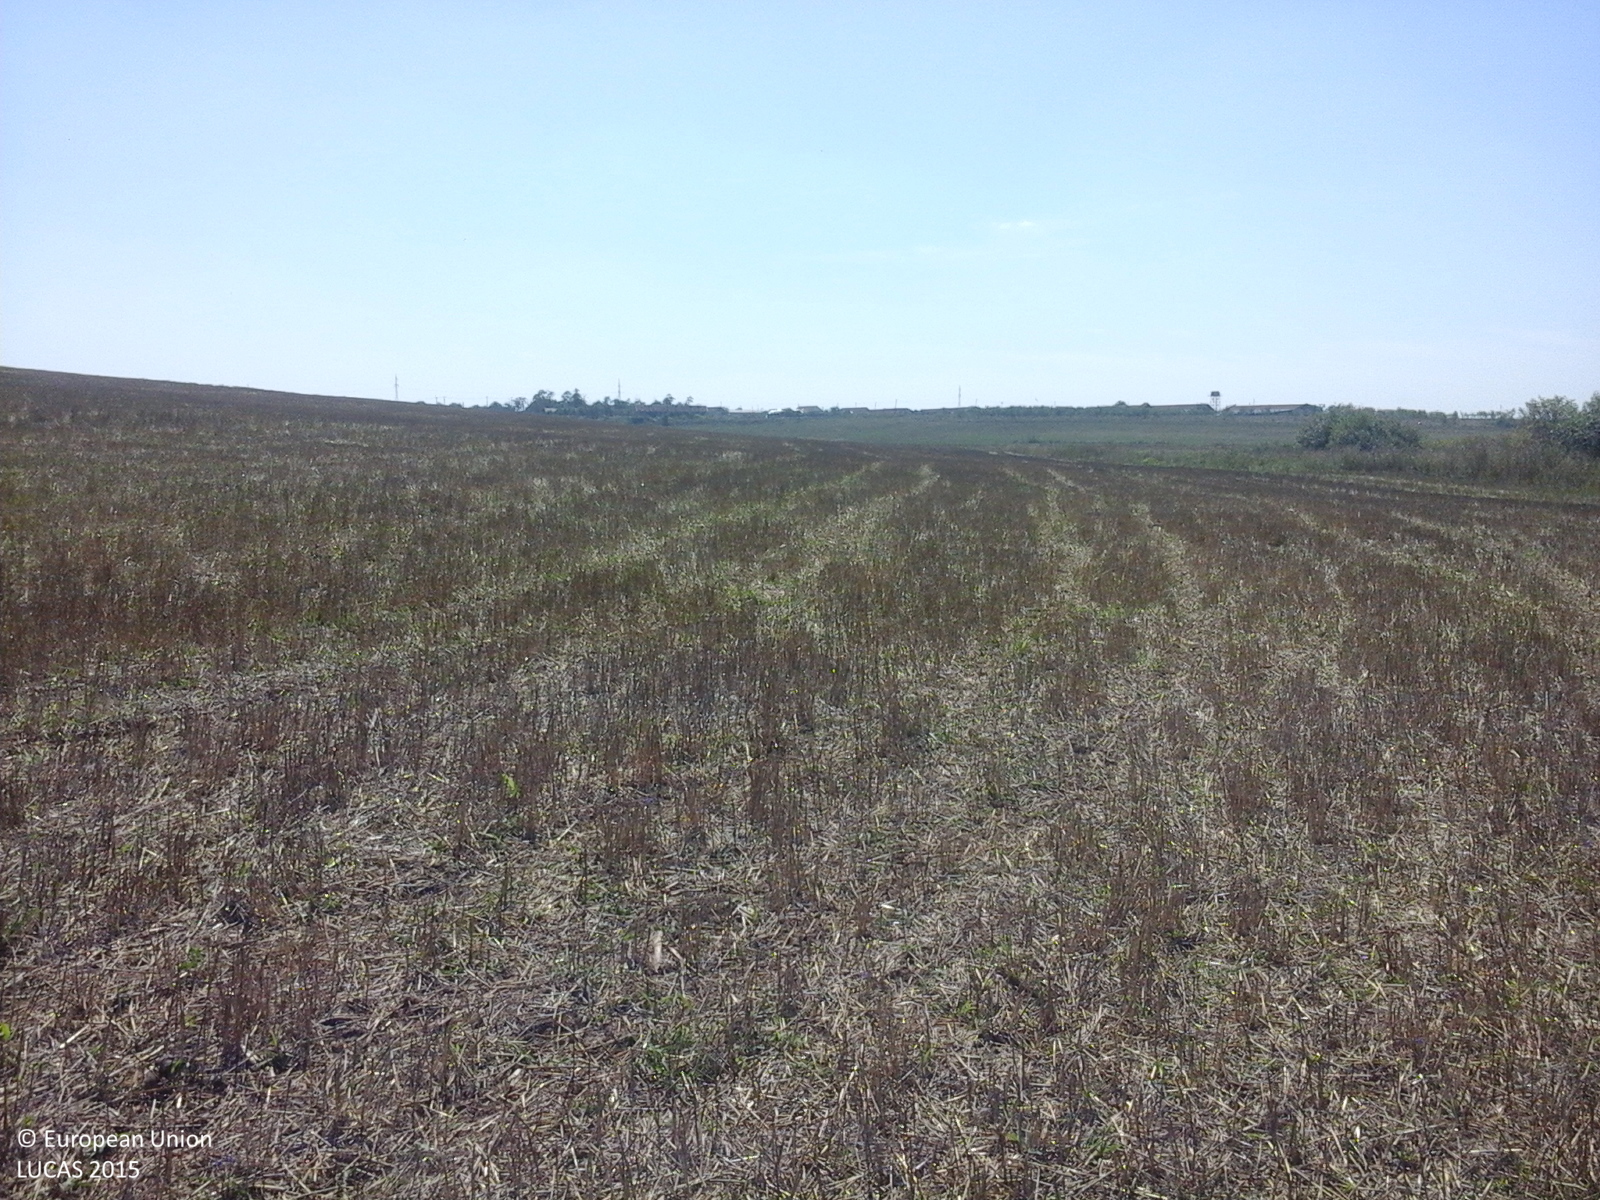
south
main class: Cropland
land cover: Common wheat
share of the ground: 50 - 75 %
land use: Agriculture (excluding fallow land and kitchen gardens)
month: August
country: RO
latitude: 45.9671
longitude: 21.1418
